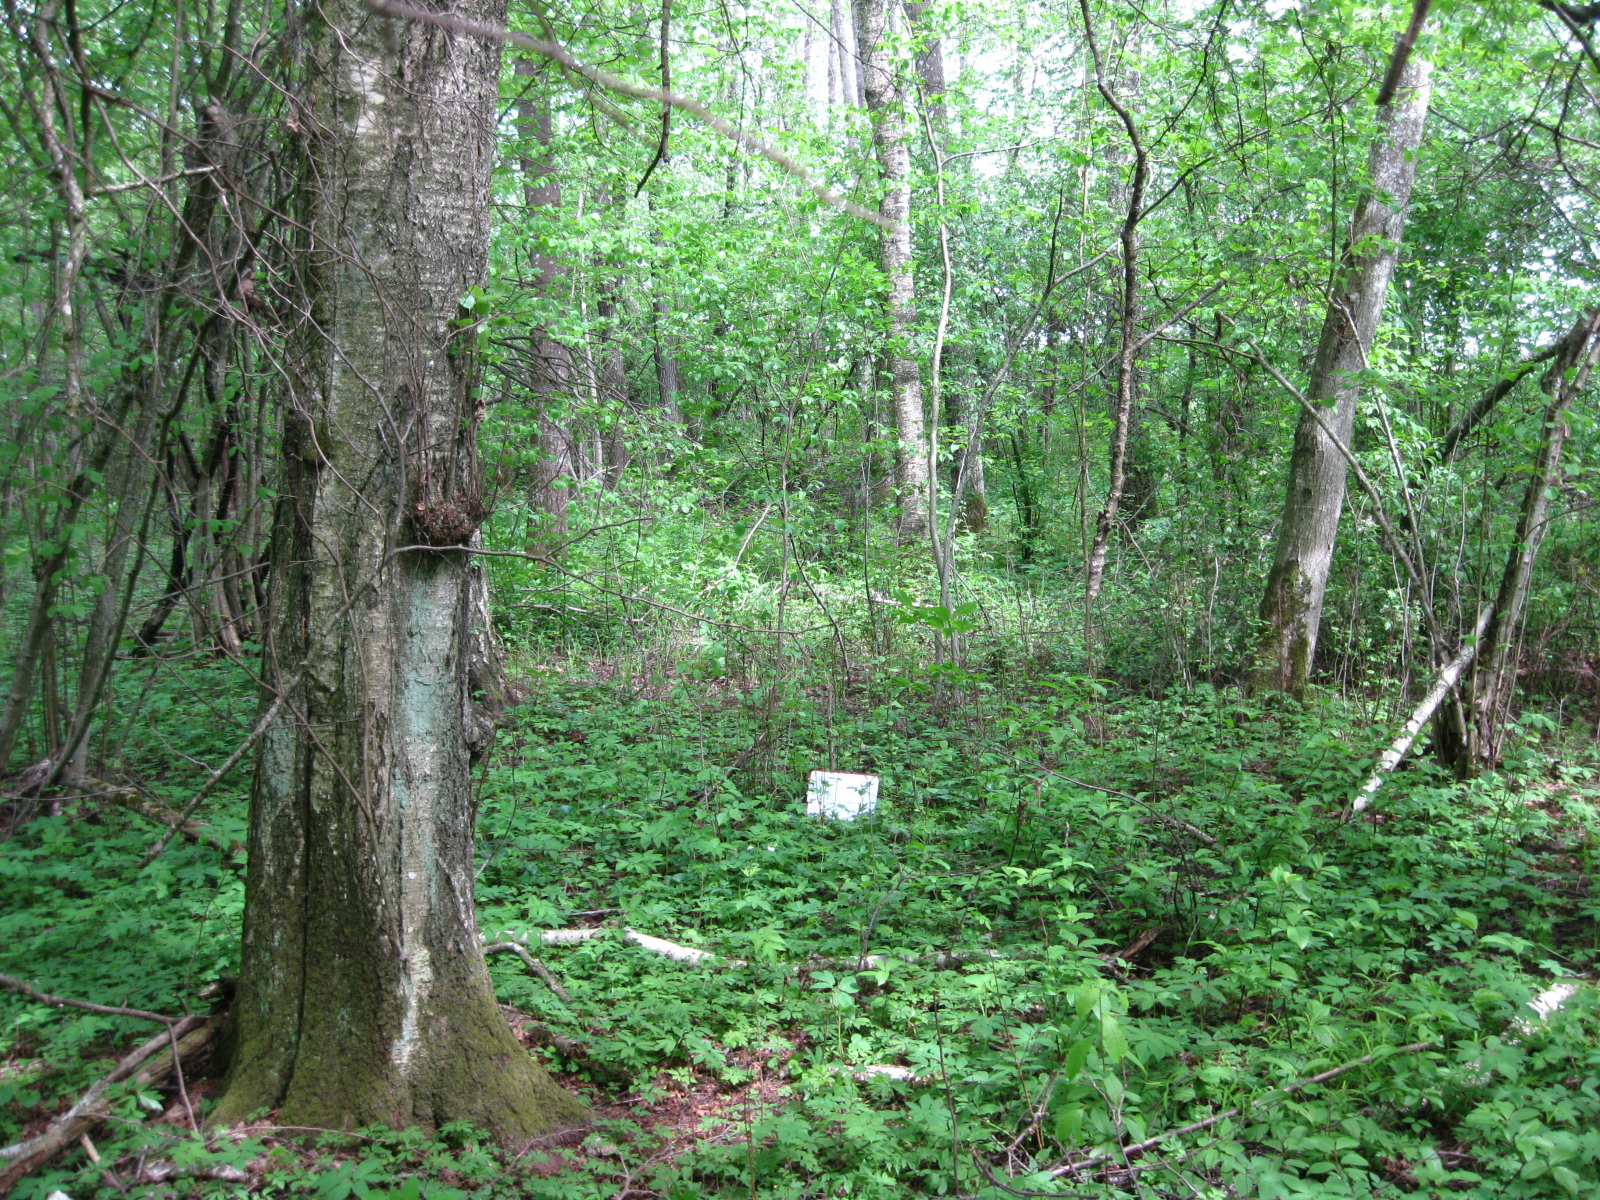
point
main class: Woodland
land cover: Broadleaved woodland
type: non-riverine alder, birch or aspen forest
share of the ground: > 75 %
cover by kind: broadleaved forest trees 85 %, shrubs 5 %, herbaceous plants 5 %, unconsolidated bare surface 5 %
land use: Forestry
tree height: > 5 m
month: May
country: LT
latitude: 56.2261
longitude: 24.2696
